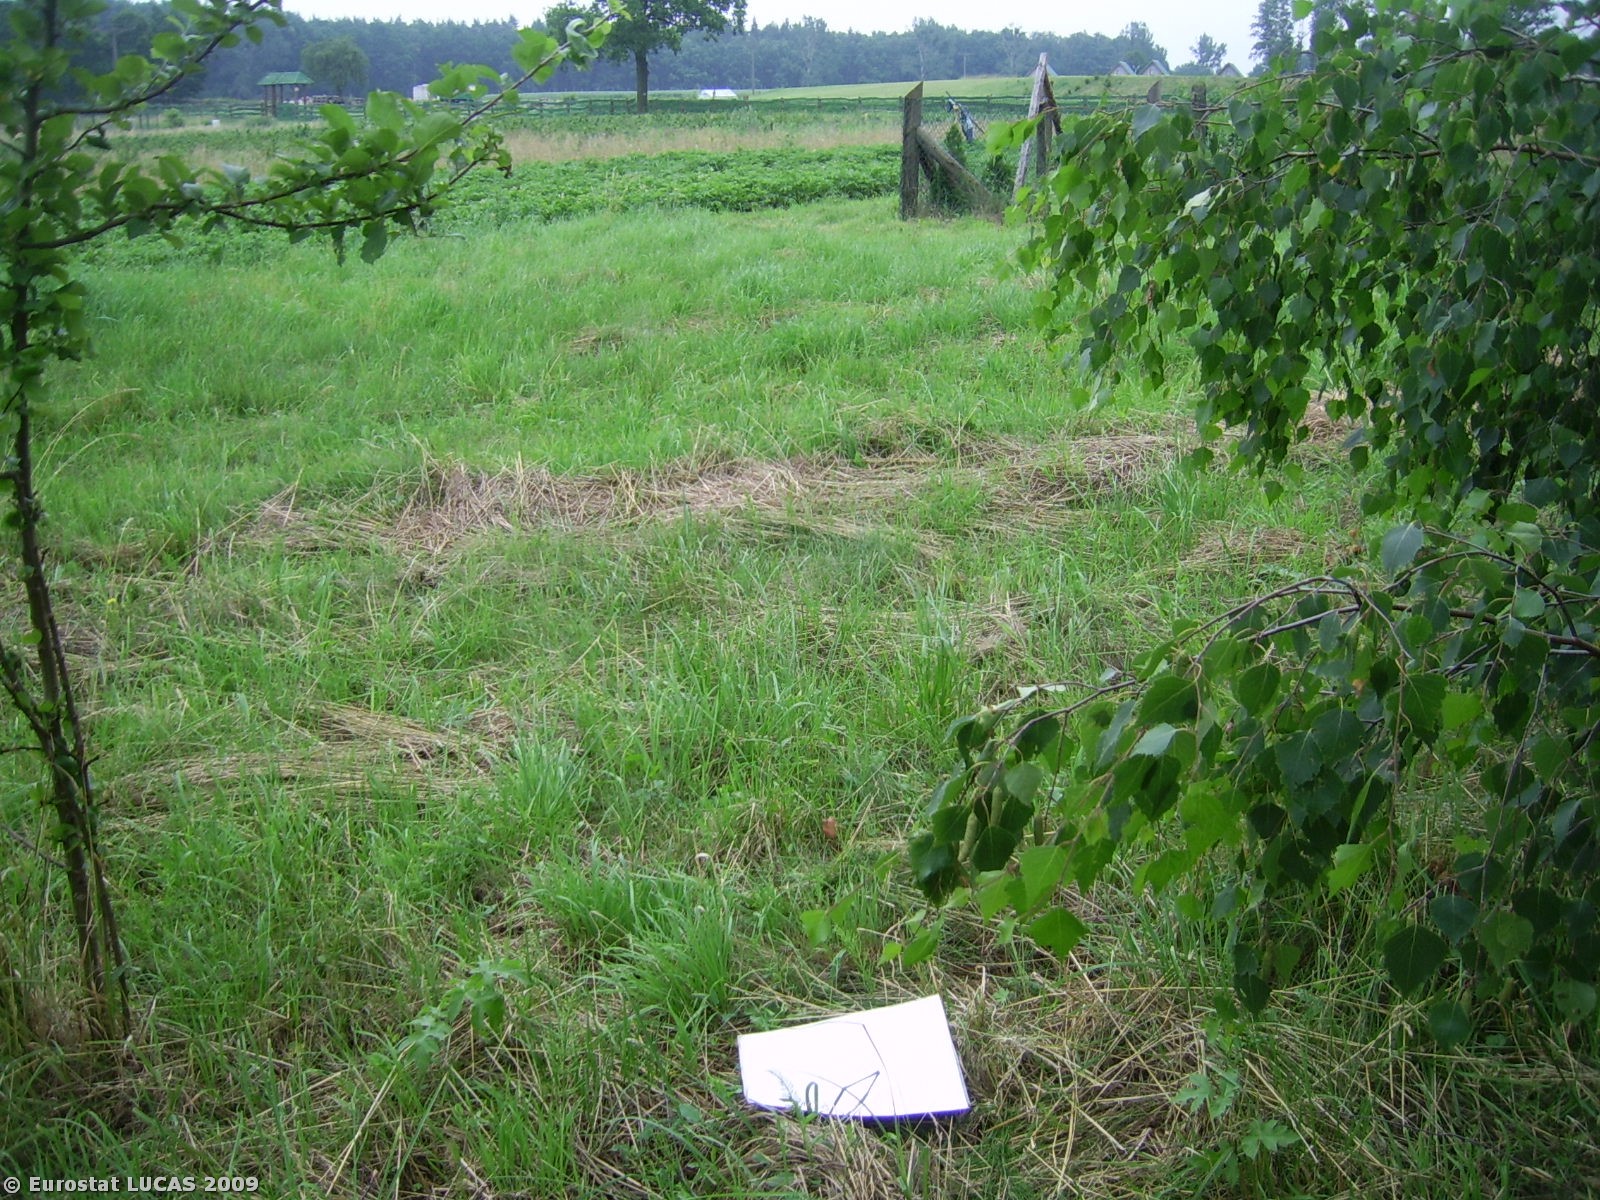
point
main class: Cropland
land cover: Common wheat
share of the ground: > 75 %
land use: Agriculture (excluding fallow land and kitchen gardens)
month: June
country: PL
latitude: 51.5000
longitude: 17.3443
